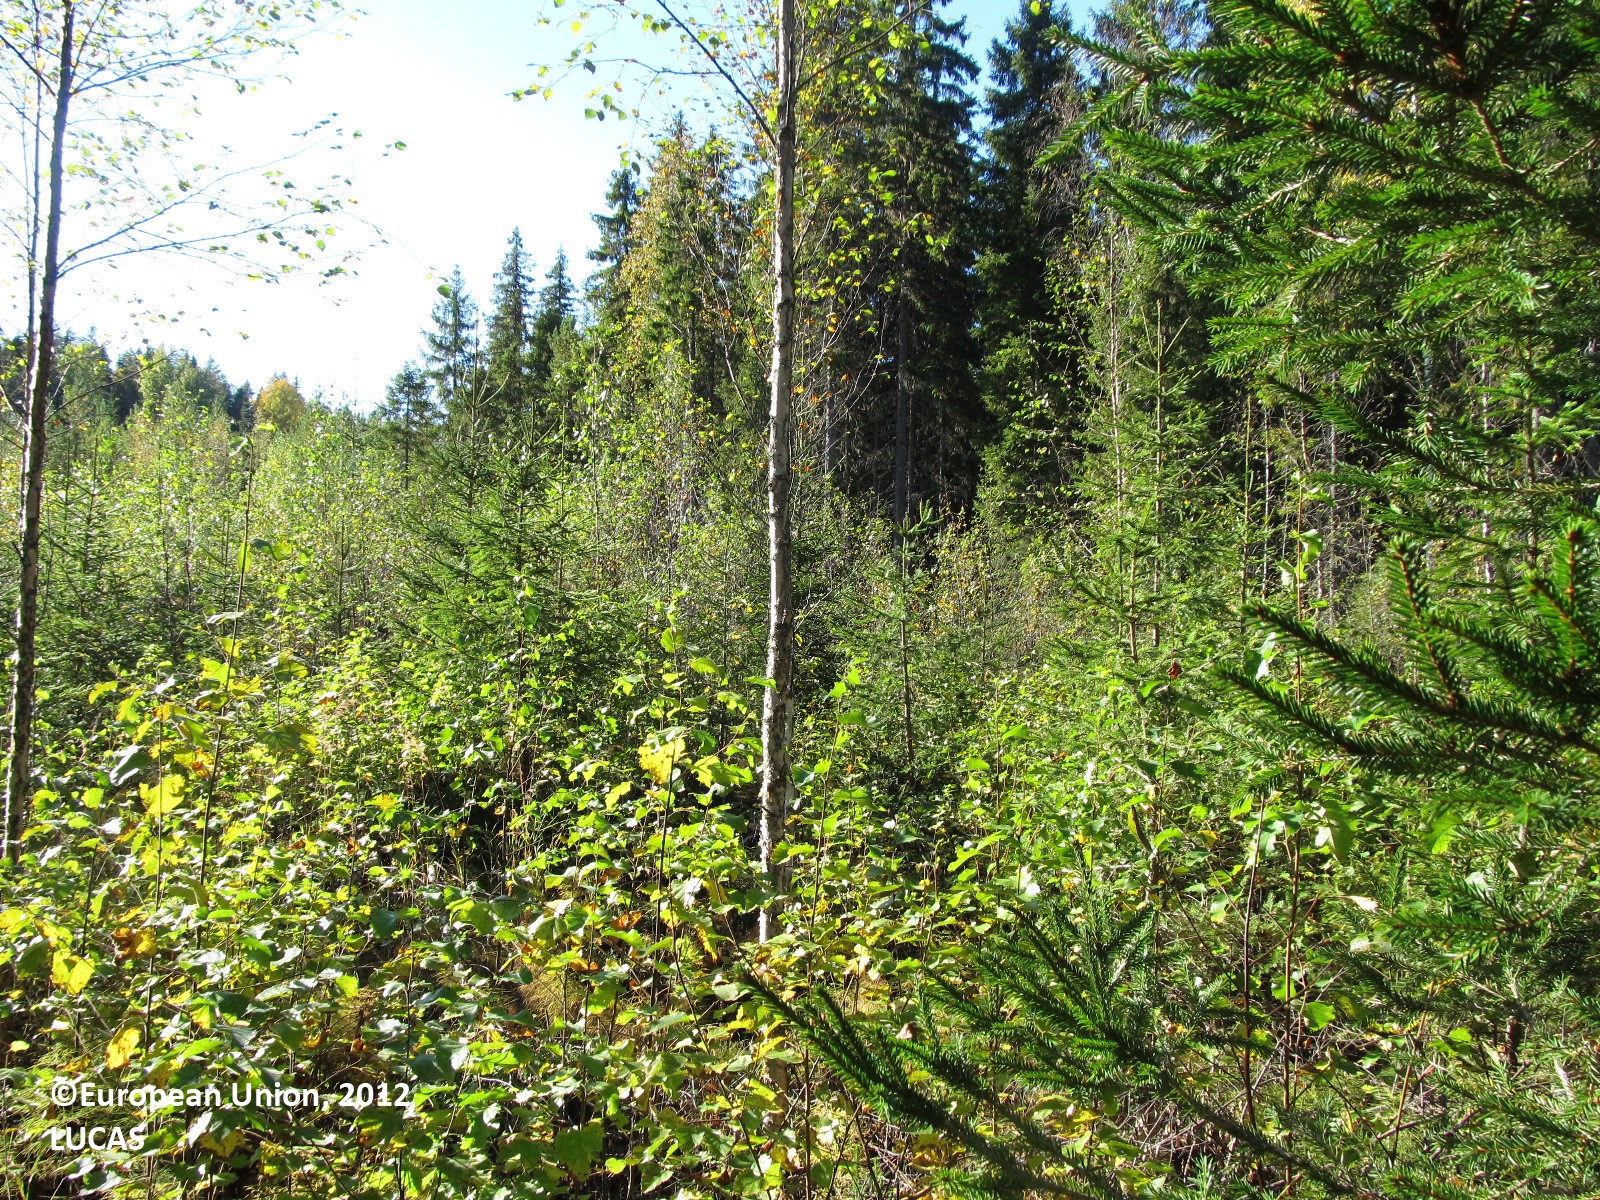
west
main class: Woodland
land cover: Spruce dominated mixed woodland
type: boreal forest
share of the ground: 50 - 75 %
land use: Forestry
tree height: > 5 m
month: September
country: FI
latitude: 62.4412
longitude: 28.3102
